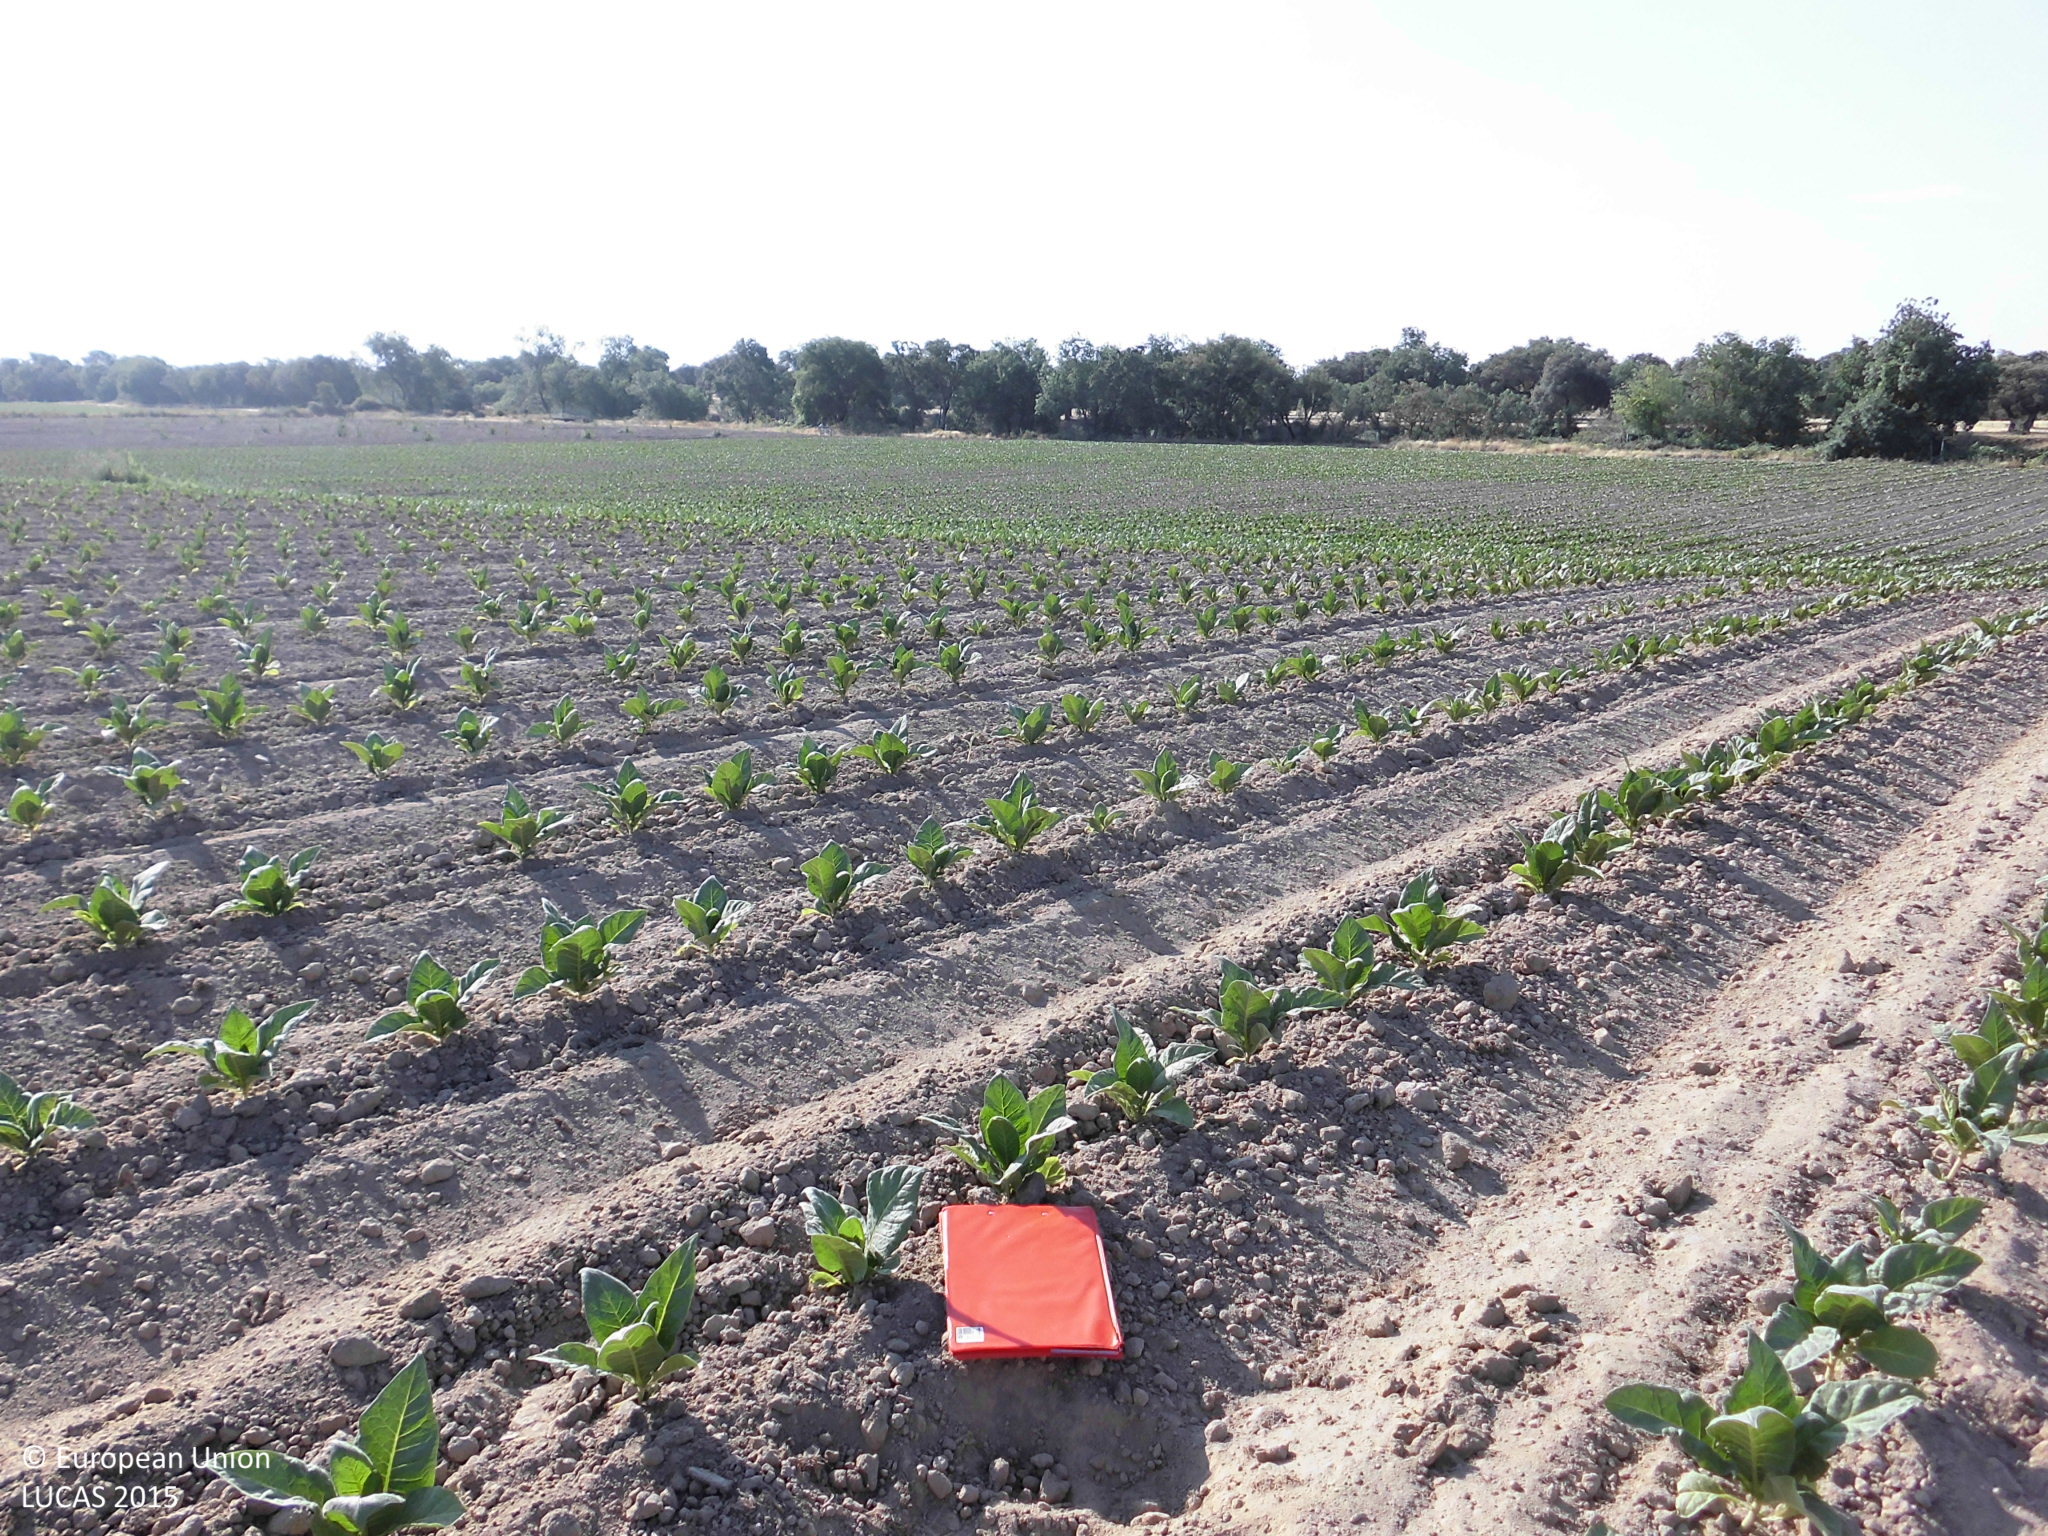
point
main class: Cropland
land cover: Tobacco
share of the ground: 10 - 25 %
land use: Agriculture (excluding fallow land and kitchen gardens)
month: June
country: ES
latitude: 39.9718
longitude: -5.4552
